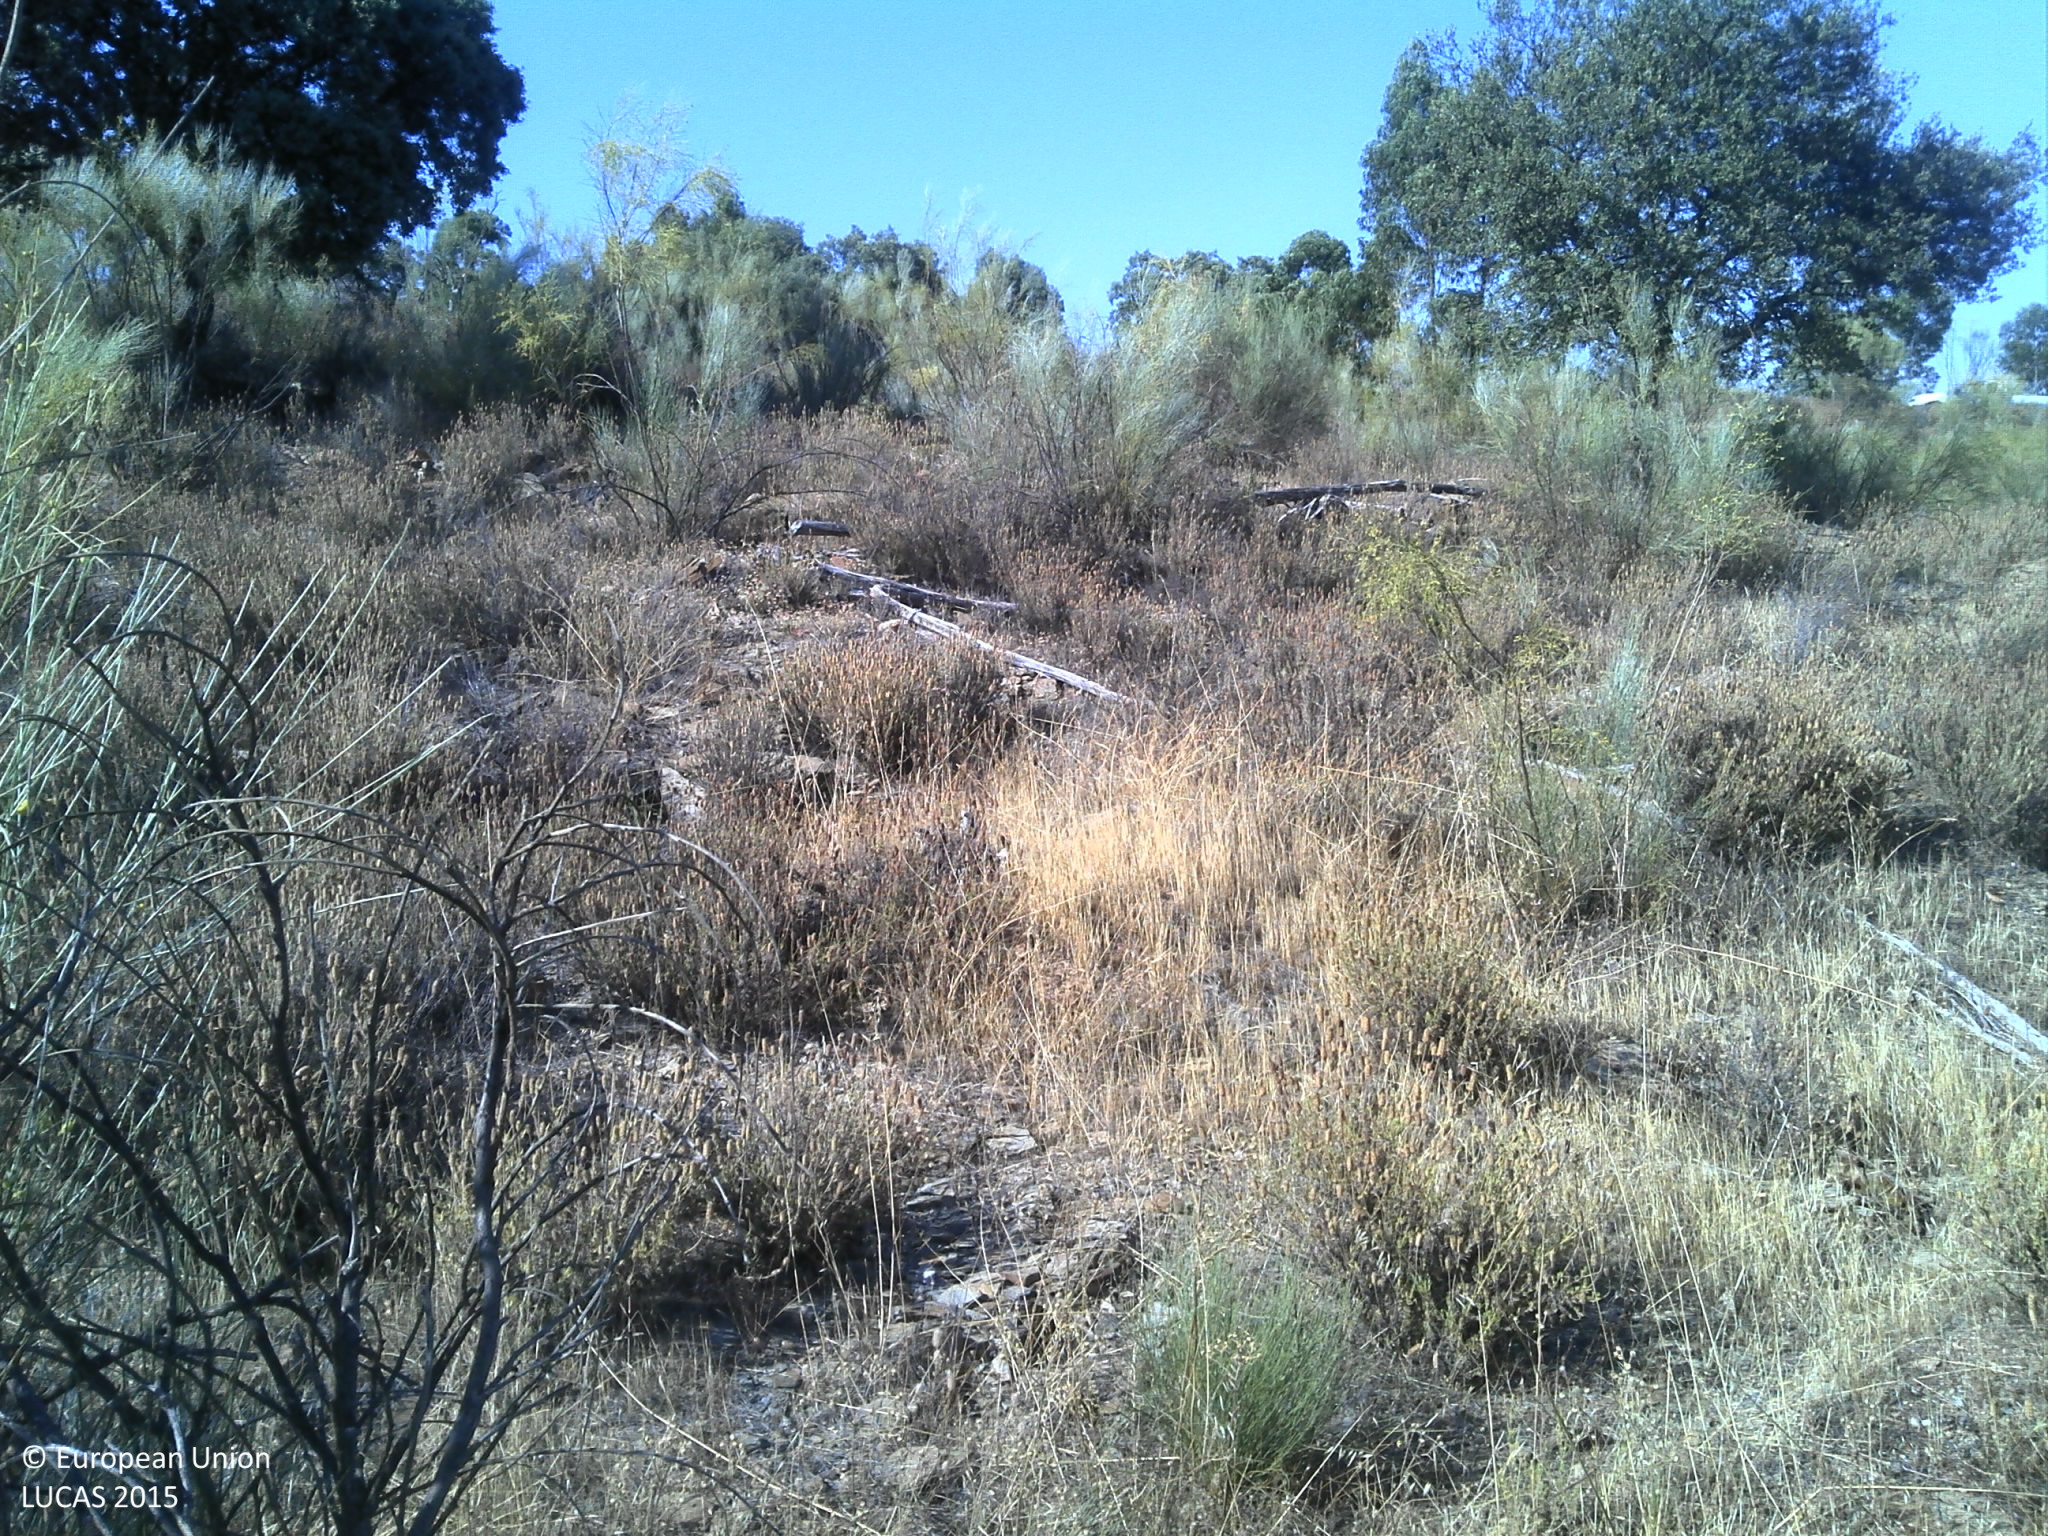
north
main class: Shrubland
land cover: Shrubland with sparse tree cover
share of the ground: 50 - 75 %
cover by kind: shrubs 50 %, herbaceous plants 25 %, unconsolidated bare surface 10 %, broadleaved forest trees 5 %
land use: Forestry
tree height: > 5 m
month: June
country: PT
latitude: 39.7940
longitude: -7.0567
